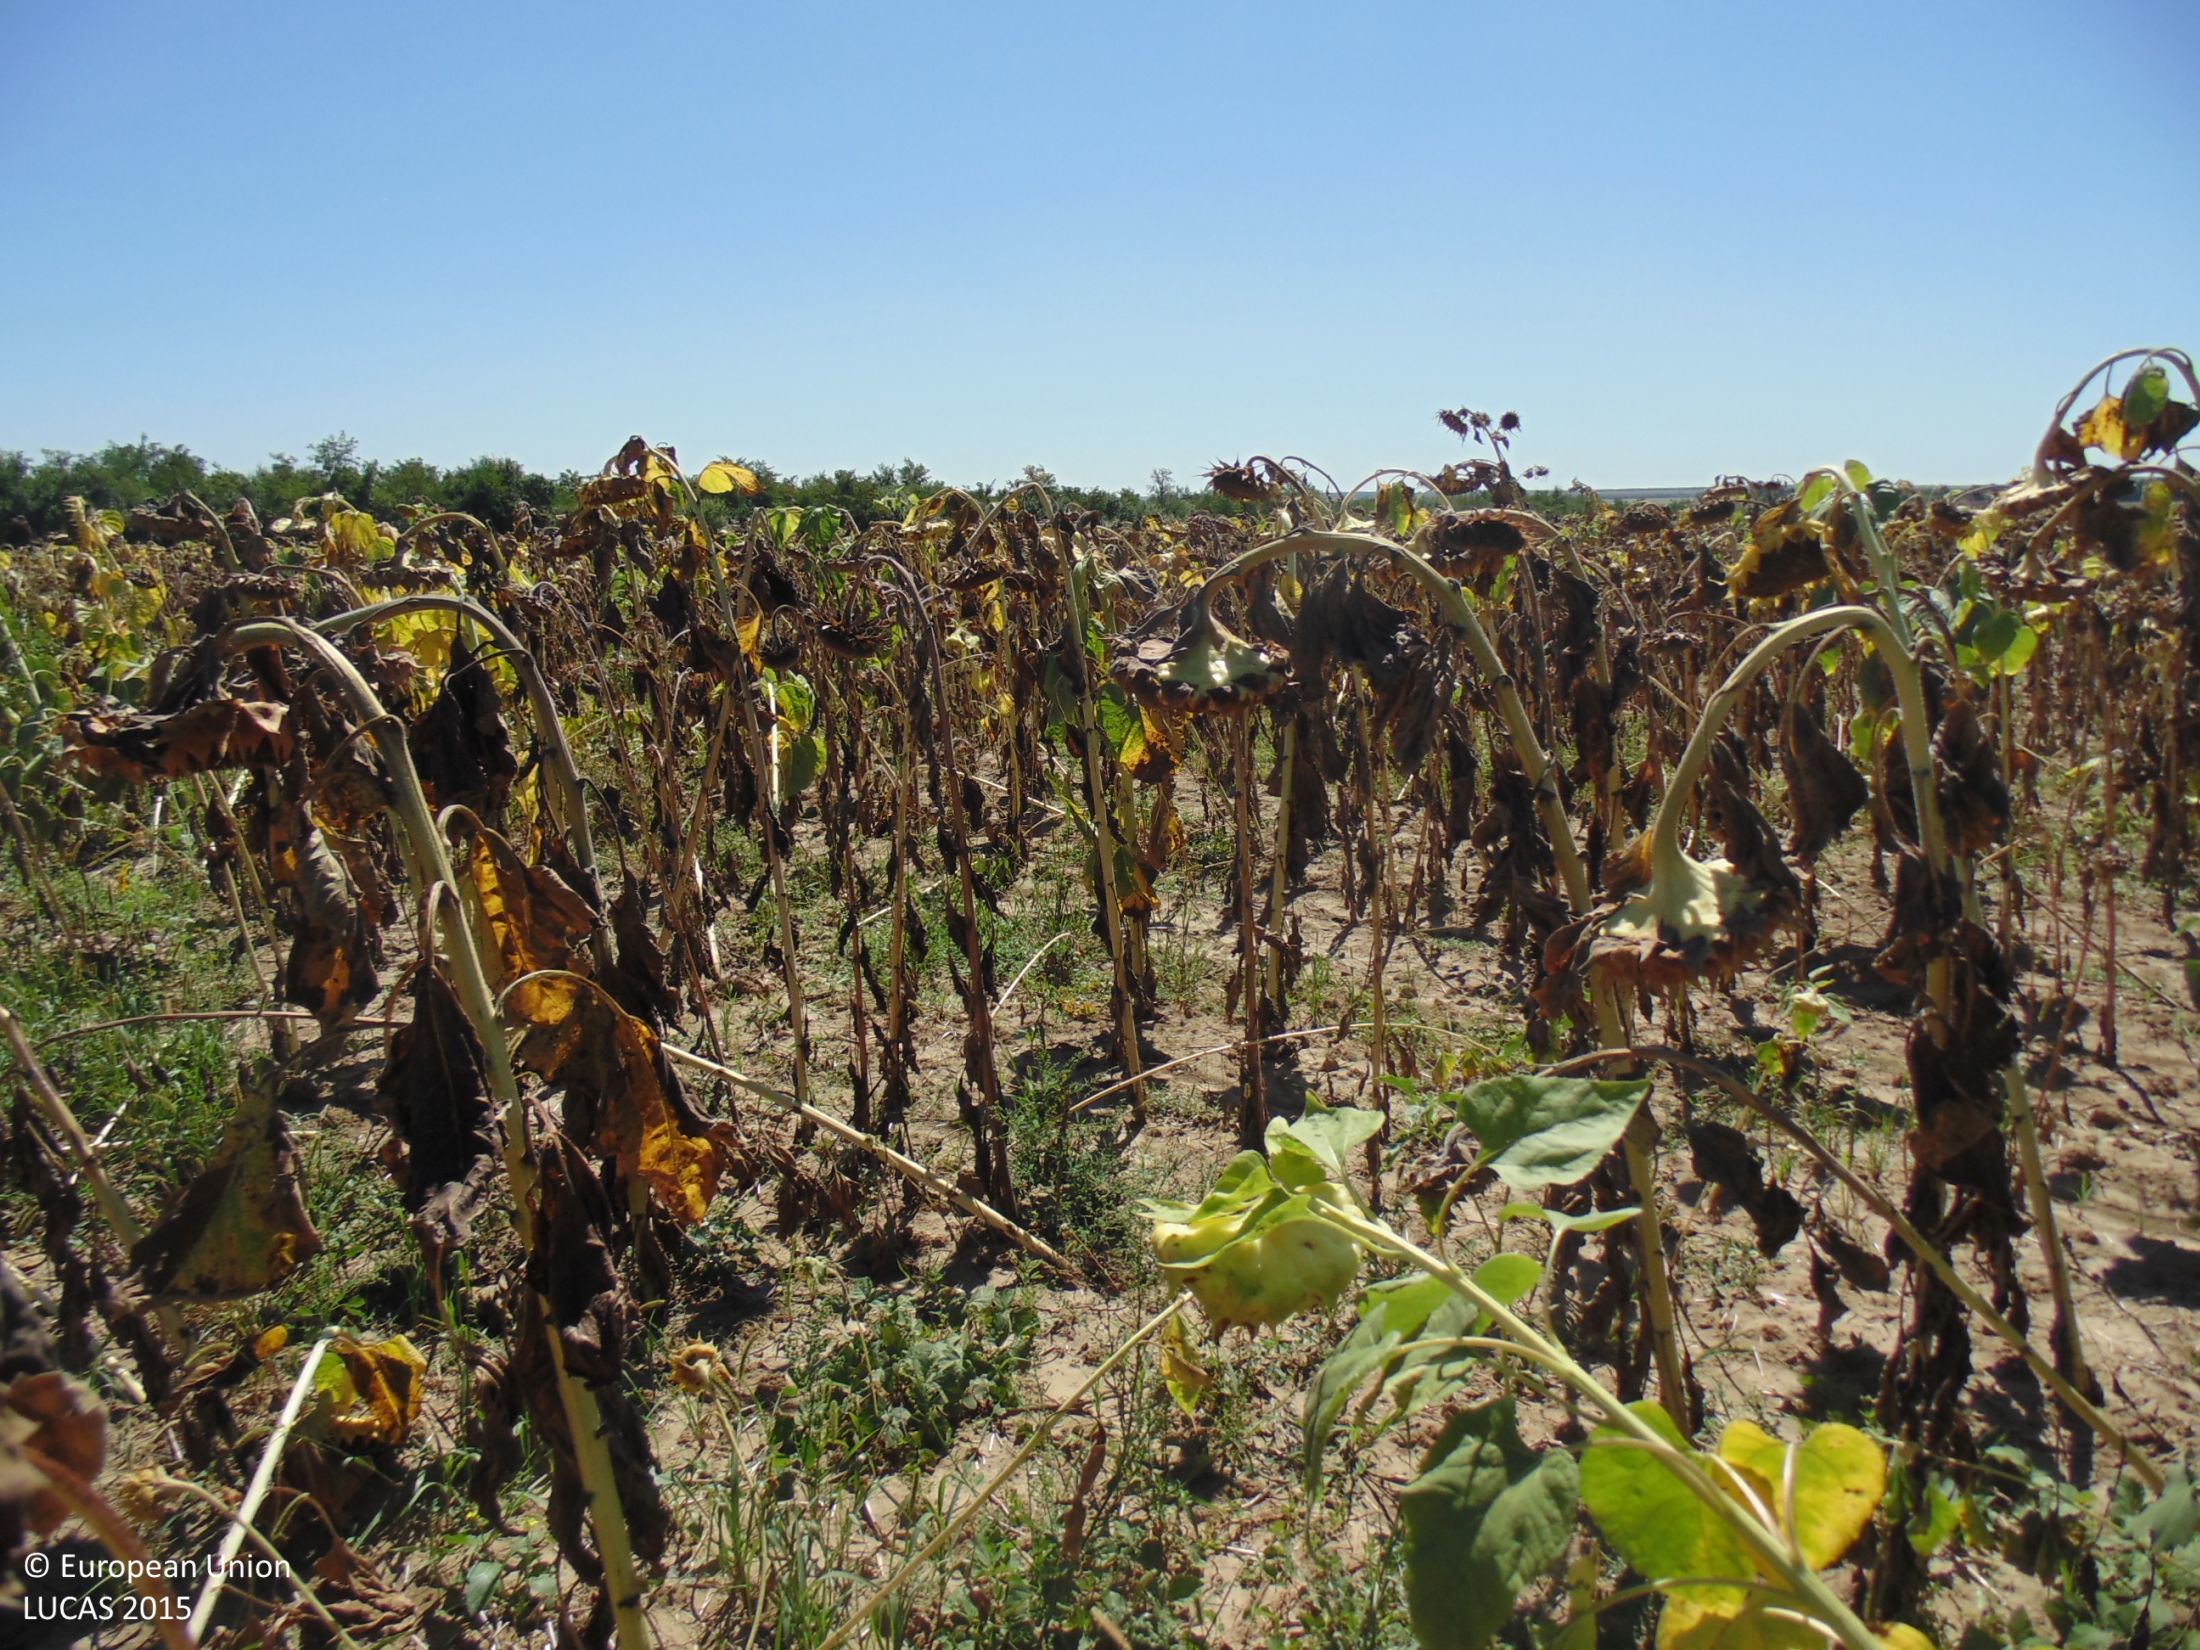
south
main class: Cropland
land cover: Sunflower
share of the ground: > 75 %
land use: Agriculture (excluding fallow land and kitchen gardens)
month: September
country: BG
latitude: 43.7643
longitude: 27.1039
